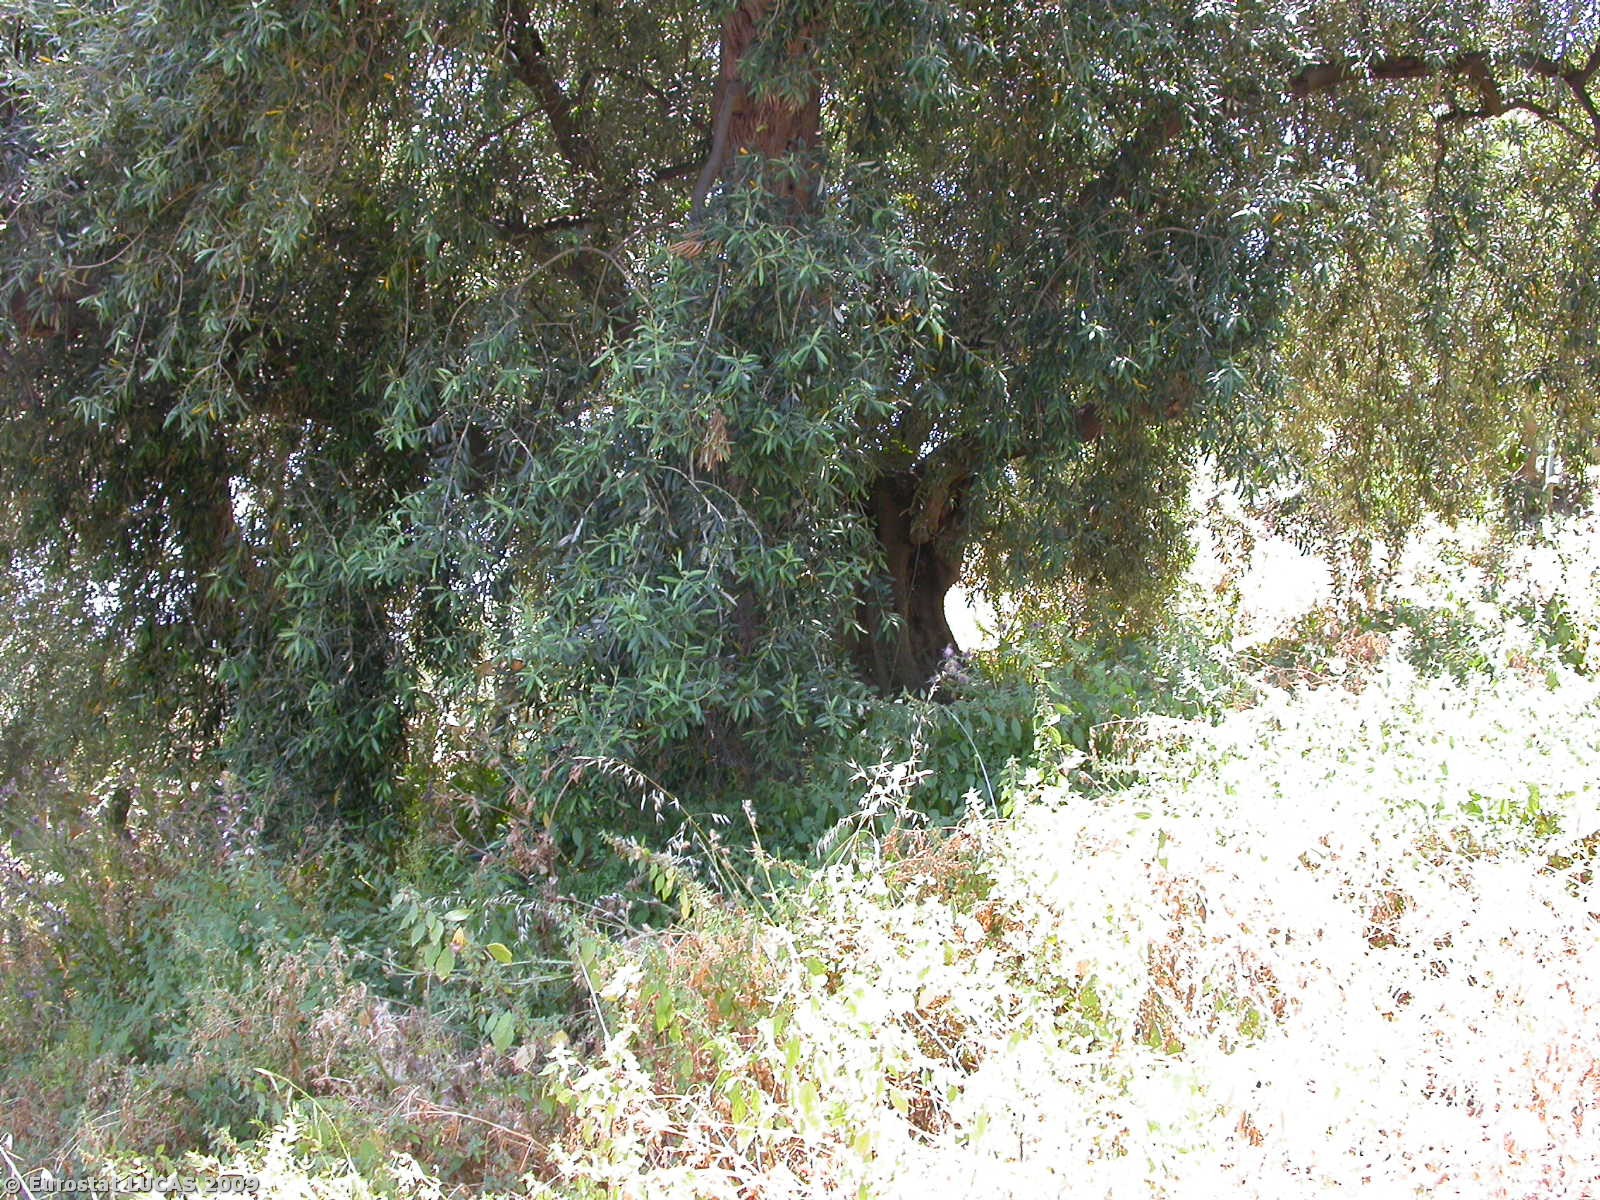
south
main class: Cropland
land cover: Olive groves
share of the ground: 50 - 75 %
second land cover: Spontaneously vegetated surfaces
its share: 50 - 75 %
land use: Agriculture (excluding fallow land and kitchen gardens)
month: June
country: IT
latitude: 38.1274
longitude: 14.9527
